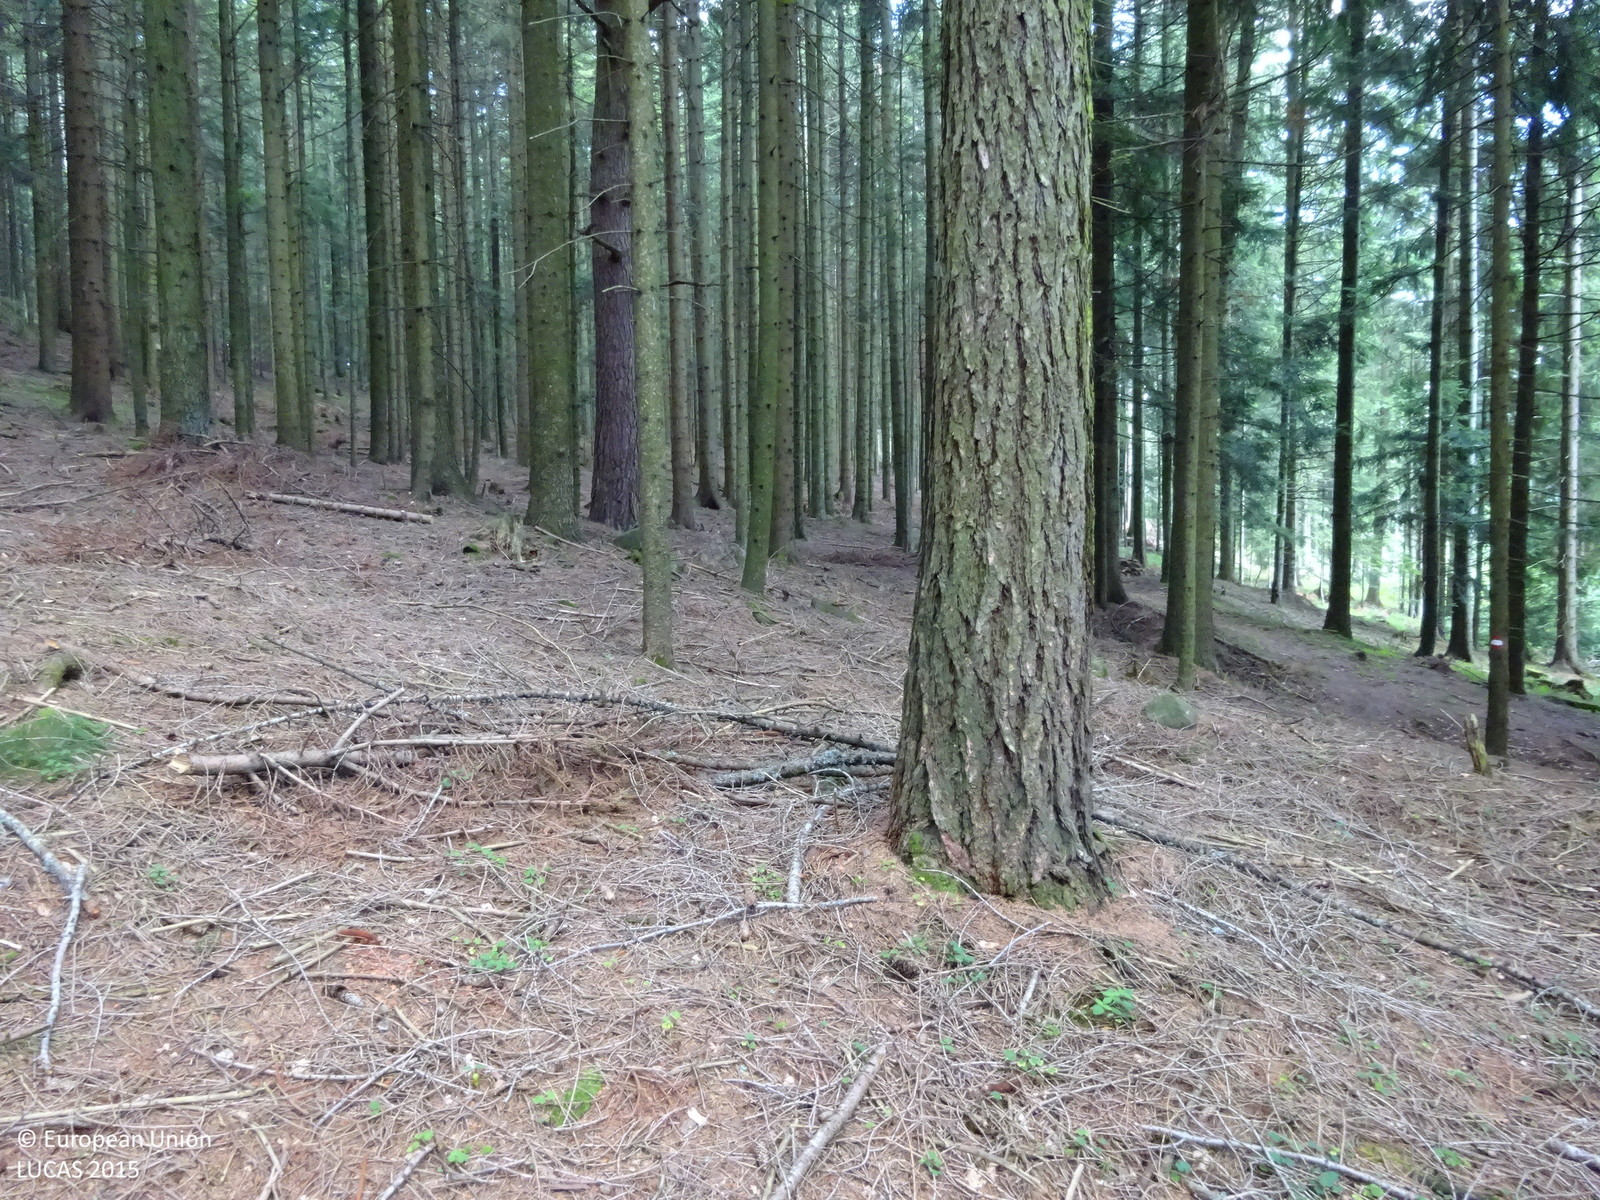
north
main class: Woodland
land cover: Spruce dominated coniferous woodland
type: alpine coniferous forest
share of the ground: > 75 %
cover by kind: coniferous forest trees 90 %, unconsolidated bare surface 10 %
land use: Forestry
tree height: > 5 m
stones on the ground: < 10 %
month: August
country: AT
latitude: 47.3513
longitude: 15.7597
